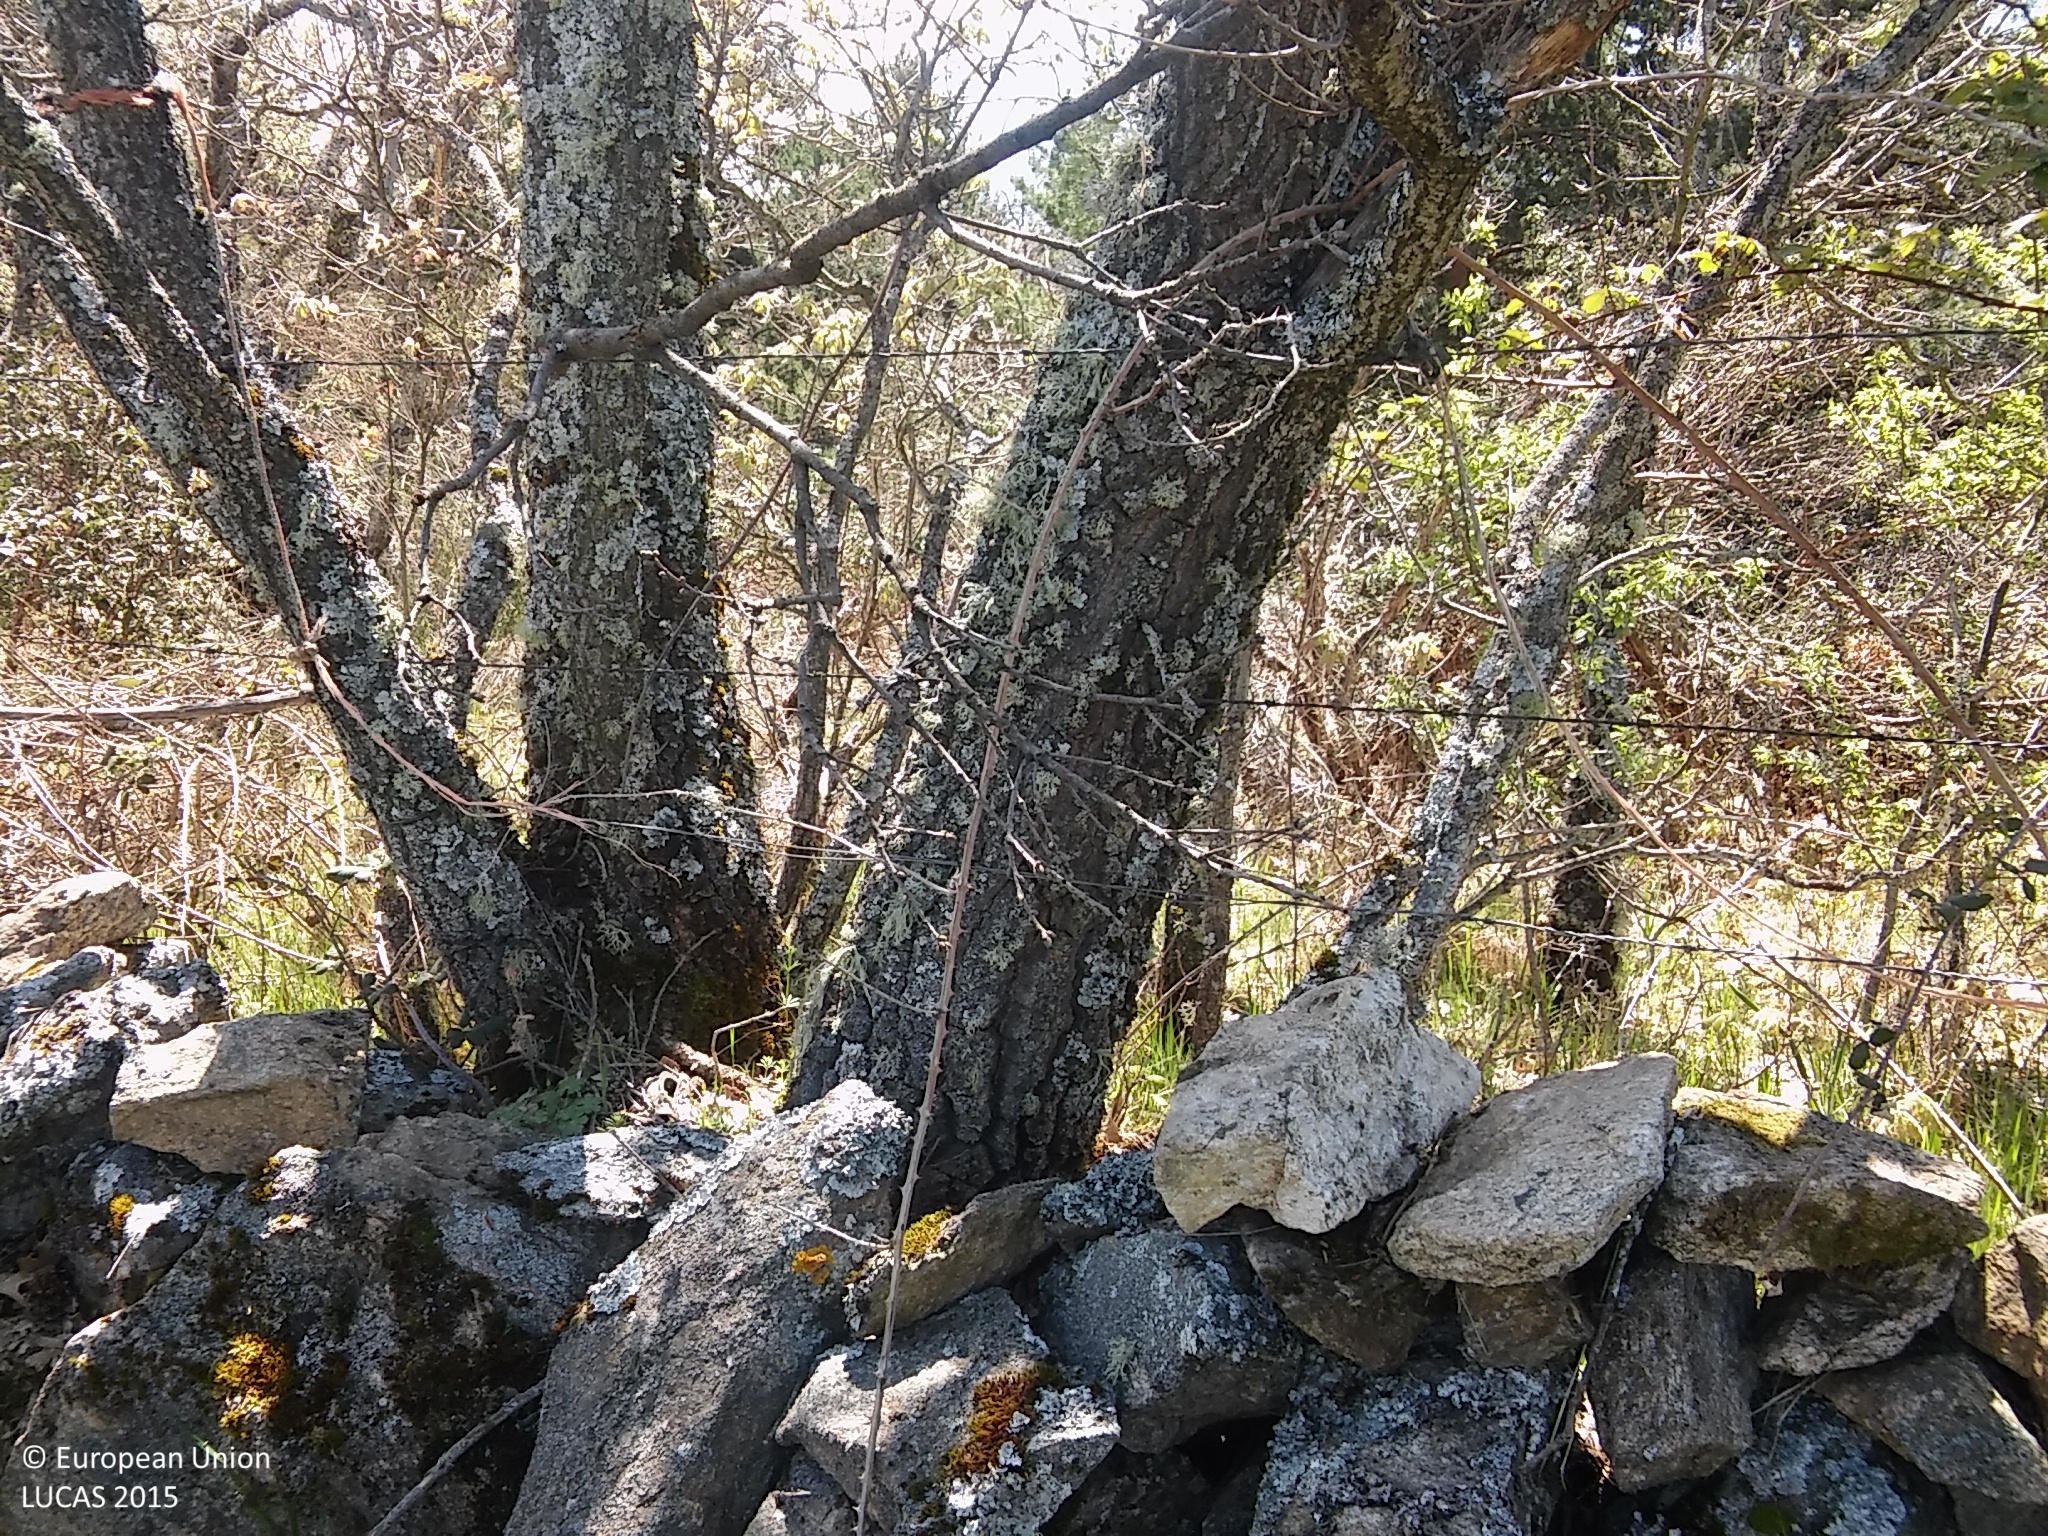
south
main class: Woodland
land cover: Broadleaved woodland
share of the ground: 25 - 50 %
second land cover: Grassland without tree/shrub cover
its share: > 75 %
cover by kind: herbaceous plants 50 %, broadleaved forest trees 45 %, shrubs 5 %
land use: Forestry
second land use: Agriculture (excluding fallow land and kitchen gardens)
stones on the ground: 10 - 25 %
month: May
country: ES
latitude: 41.0695
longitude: -3.8893
